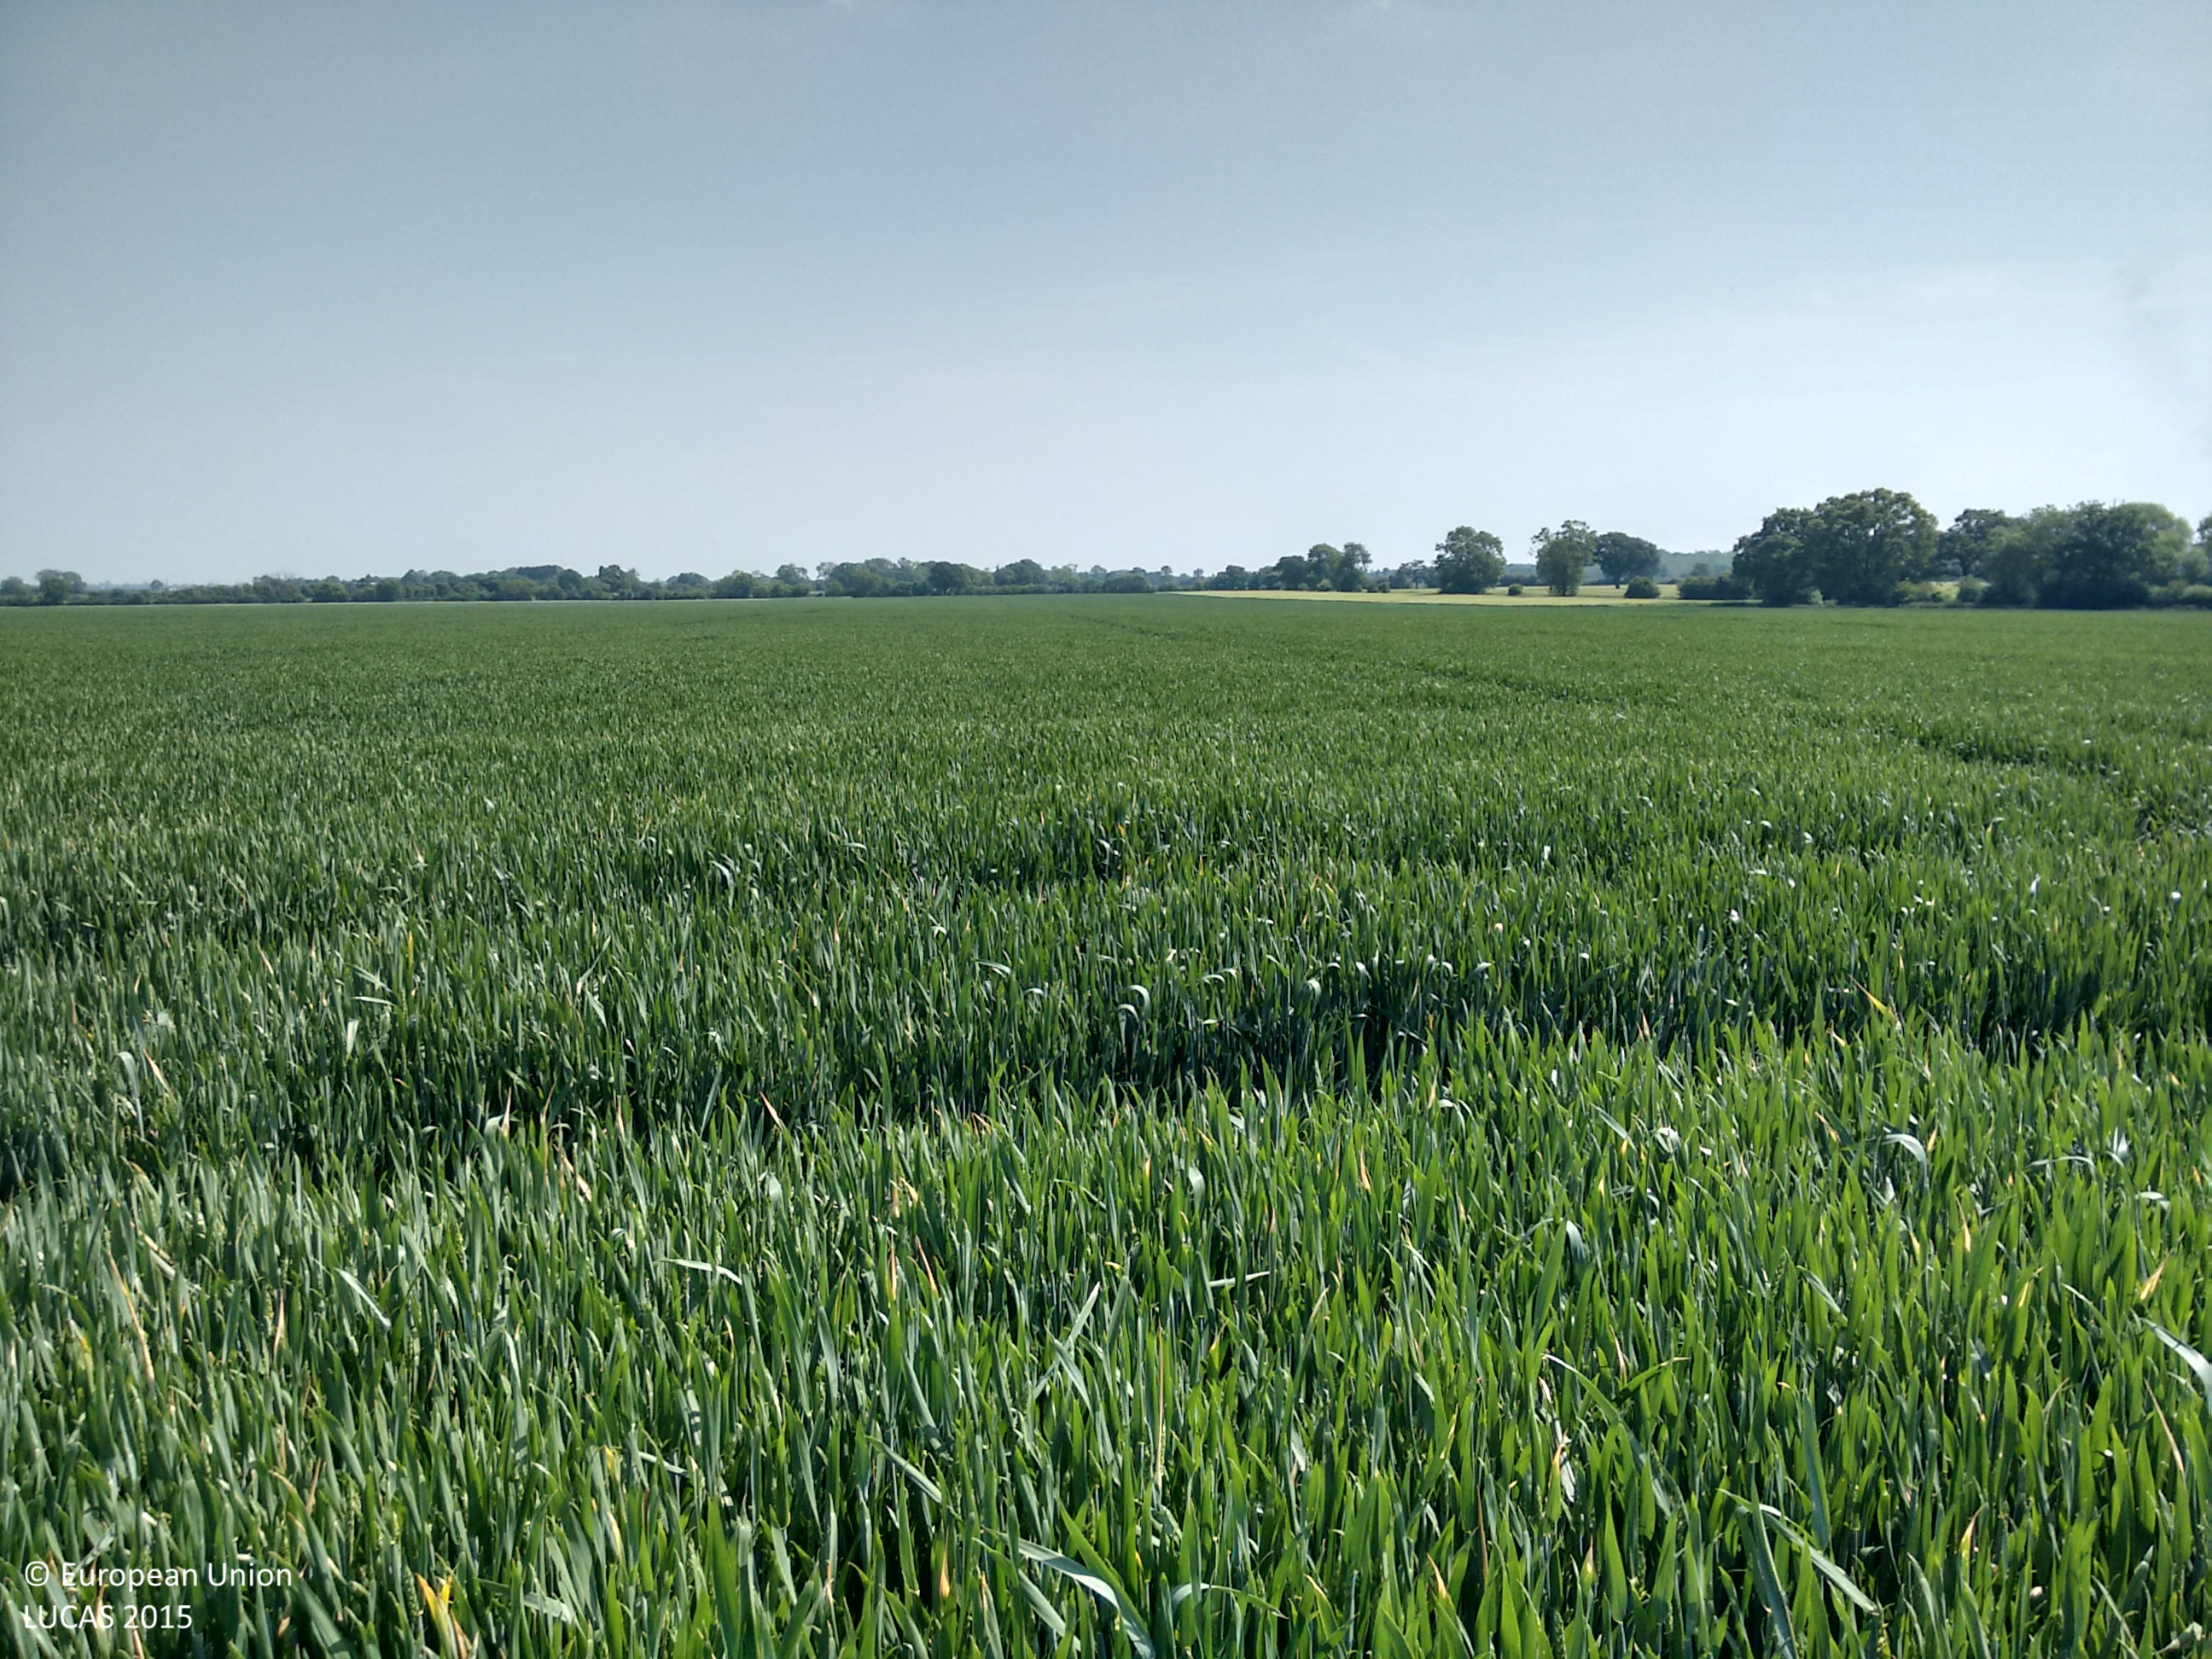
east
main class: Cropland
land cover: Common wheat
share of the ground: > 75 %
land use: Agriculture (excluding fallow land and kitchen gardens)
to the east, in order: Common wheat
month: June
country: GB
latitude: 53.9328
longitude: -1.2099
